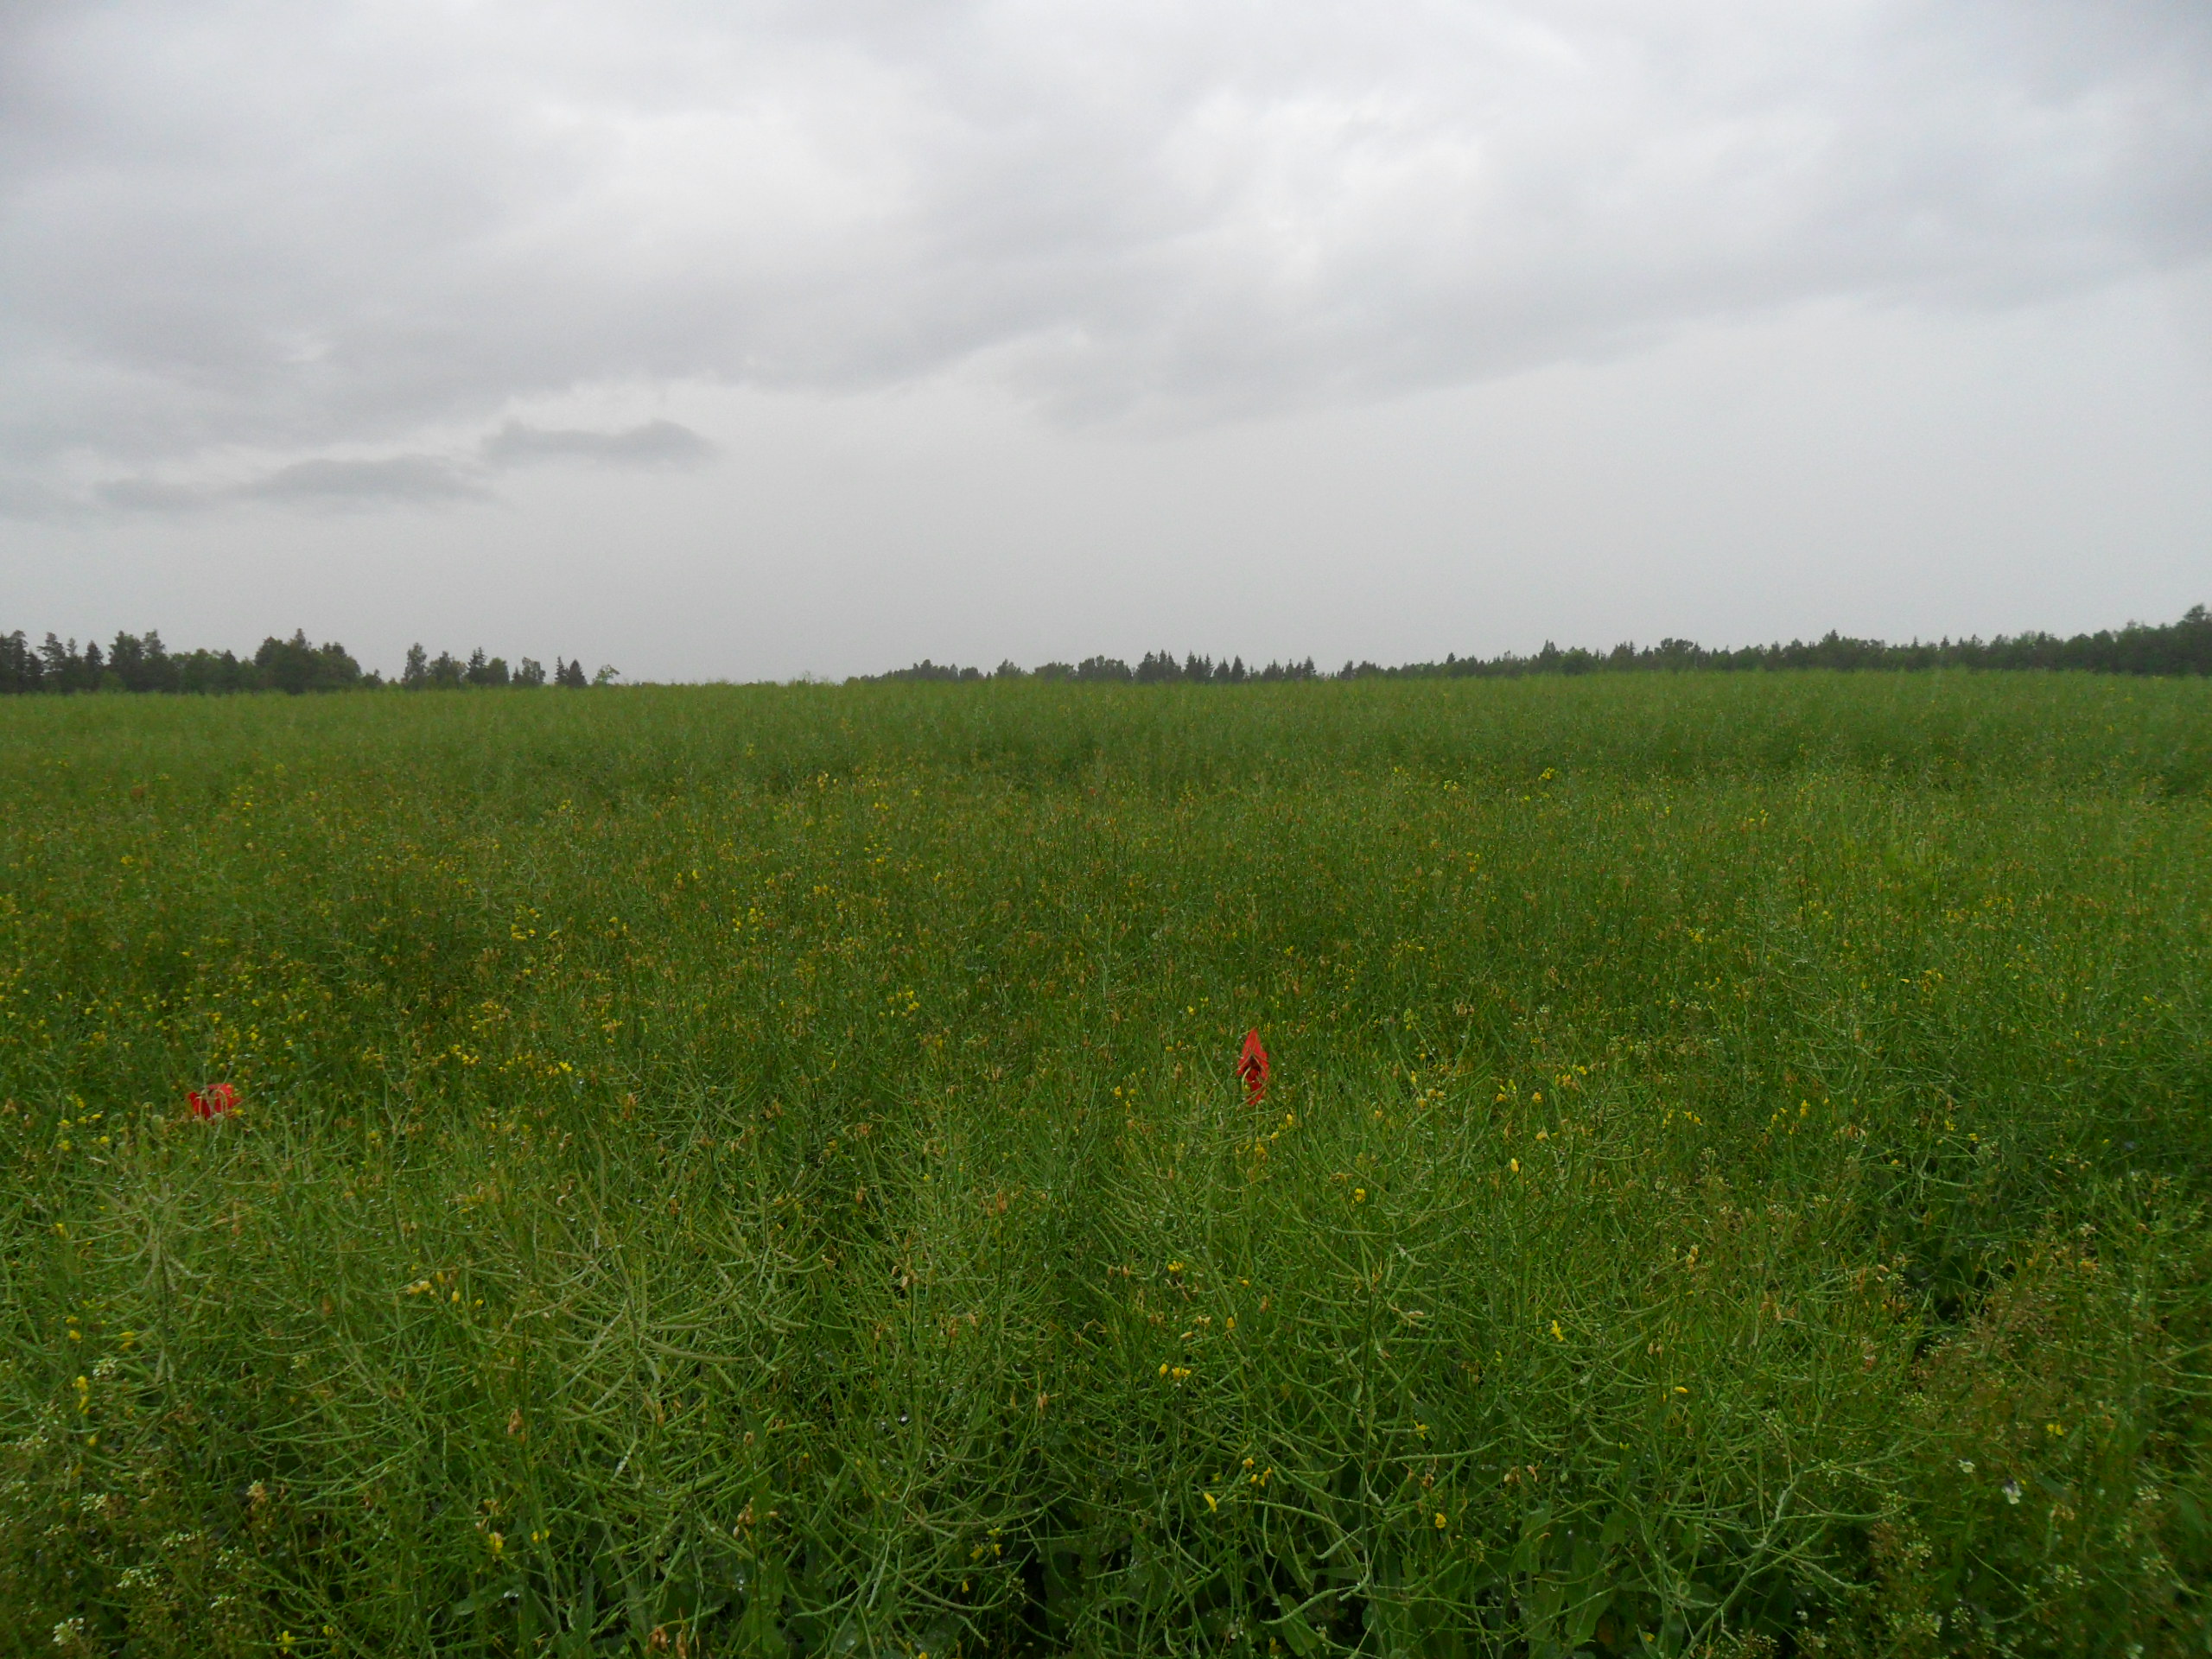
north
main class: Cropland
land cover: Rape and turnip rape
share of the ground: > 75 %
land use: Agriculture (excluding fallow land and kitchen gardens)
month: June
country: LV
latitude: 57.3723
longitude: 22.1709
